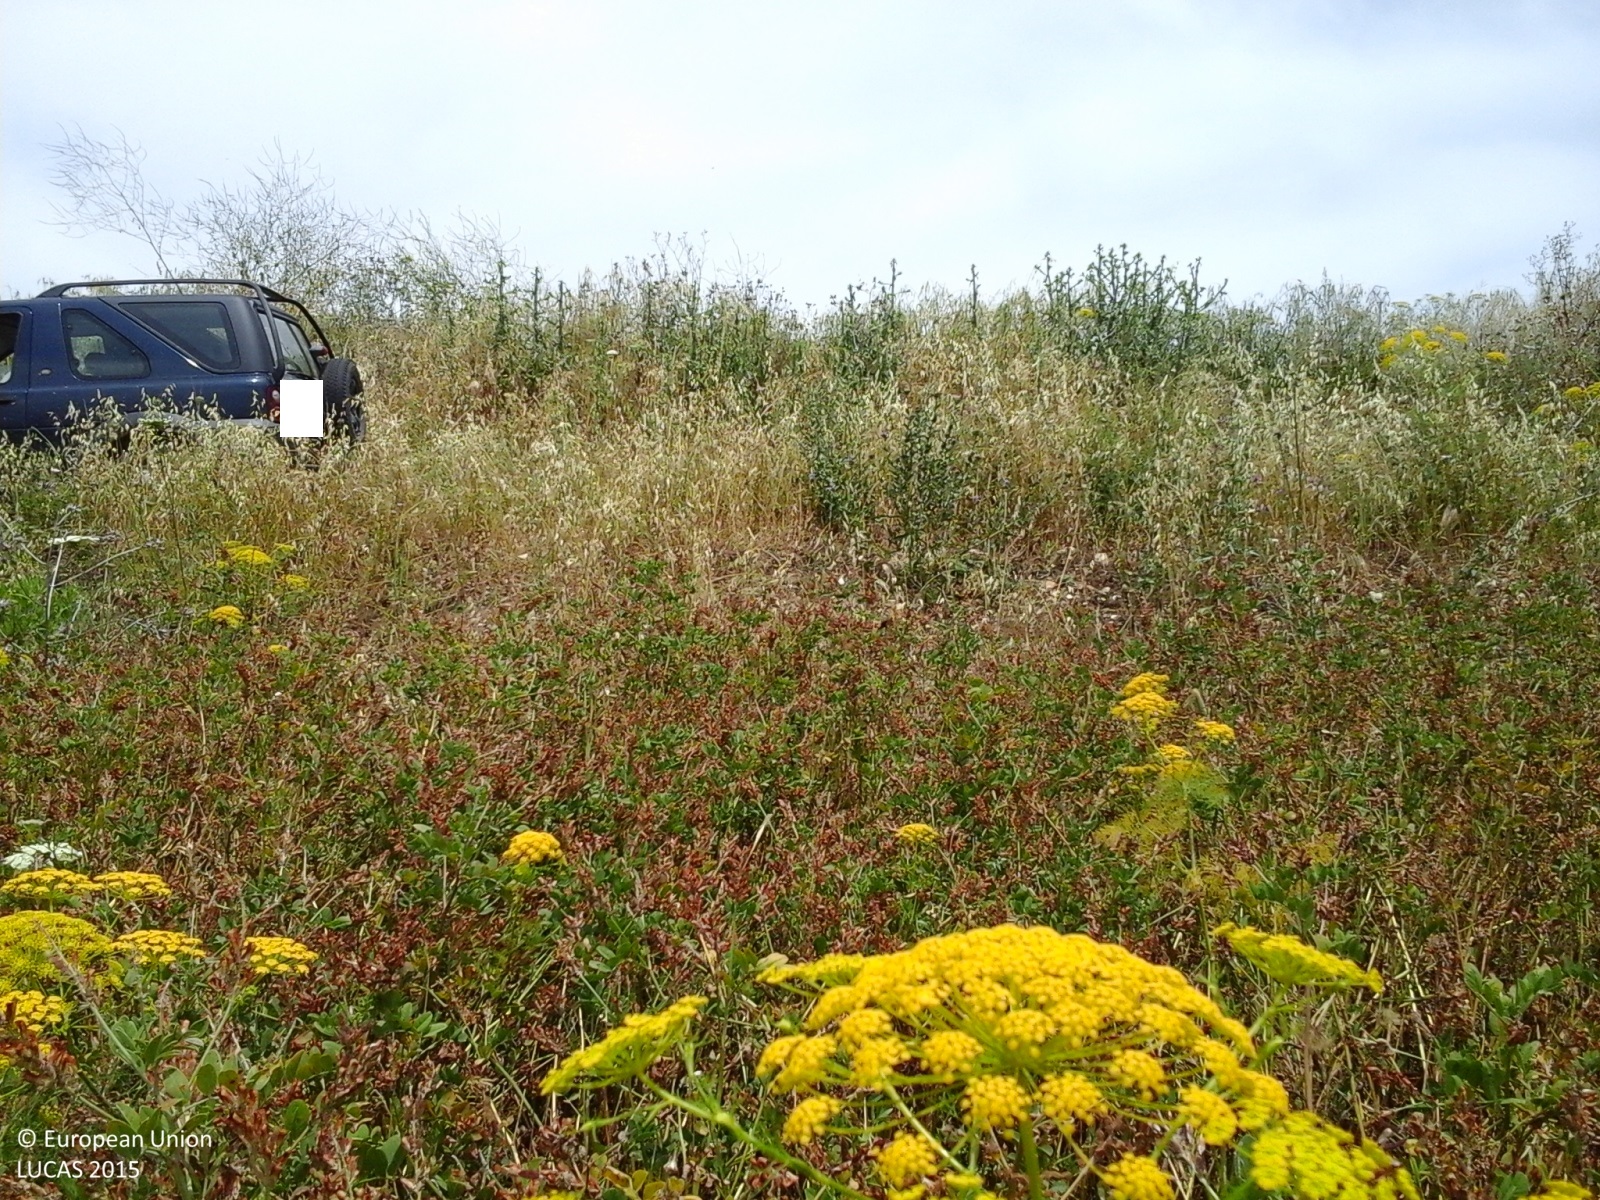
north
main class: Cropland
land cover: Other leguminous and mixtures for fodder
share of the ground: > 75 %
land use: Agriculture (excluding fallow land and kitchen gardens)
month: May
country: IT
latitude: 37.9370
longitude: 13.5135
